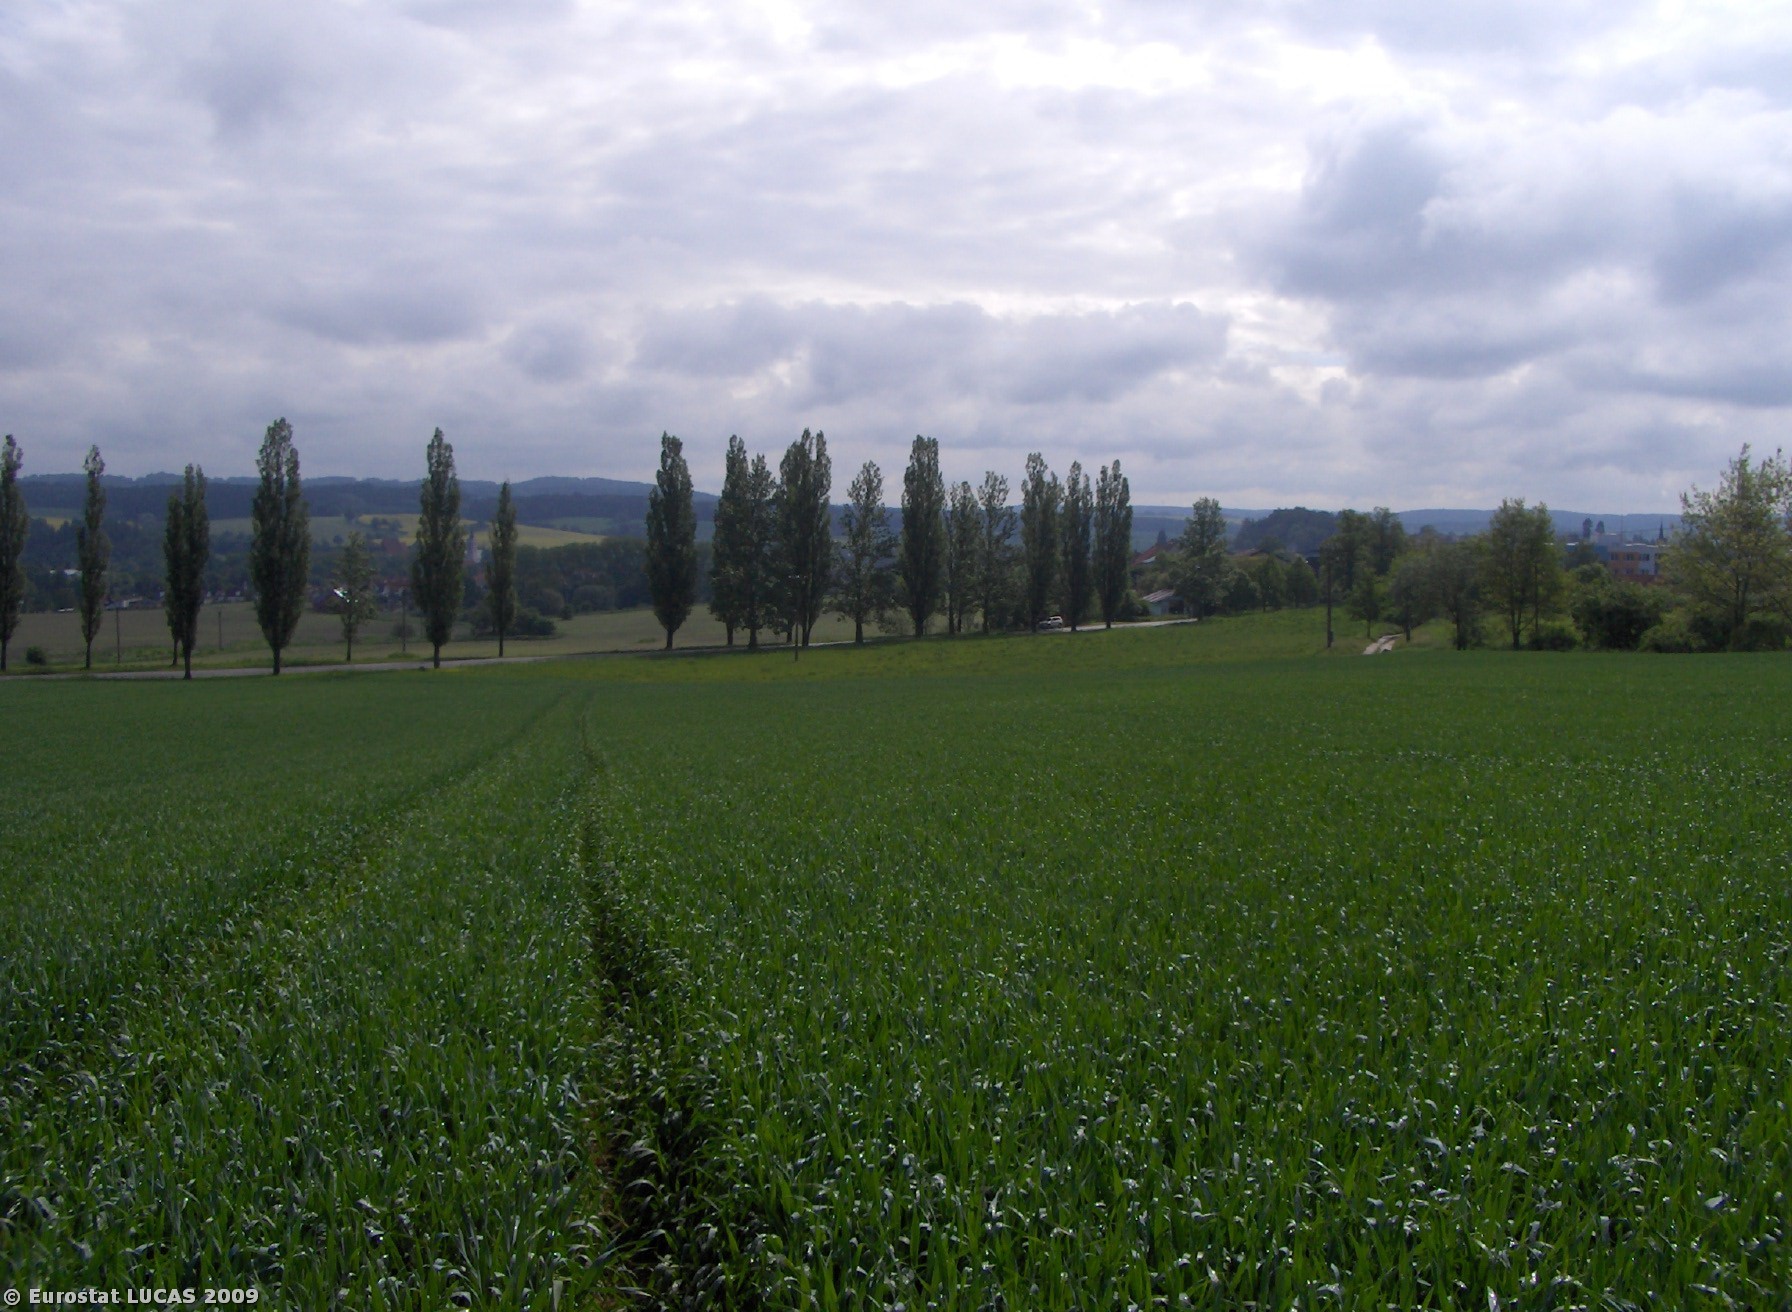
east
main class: Cropland
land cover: Common wheat
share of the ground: > 75 %
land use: Agriculture (excluding fallow land and kitchen gardens)
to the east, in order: Common wheat; Grassland without tree/shrub cover; Electric lines; Grassland without tree/shrub cover; Lines of trees; Ditches and canals; Paved roads, cycling and walking lanes; Lines of trees
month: May
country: CZ
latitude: 49.4530
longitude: 14.3465
